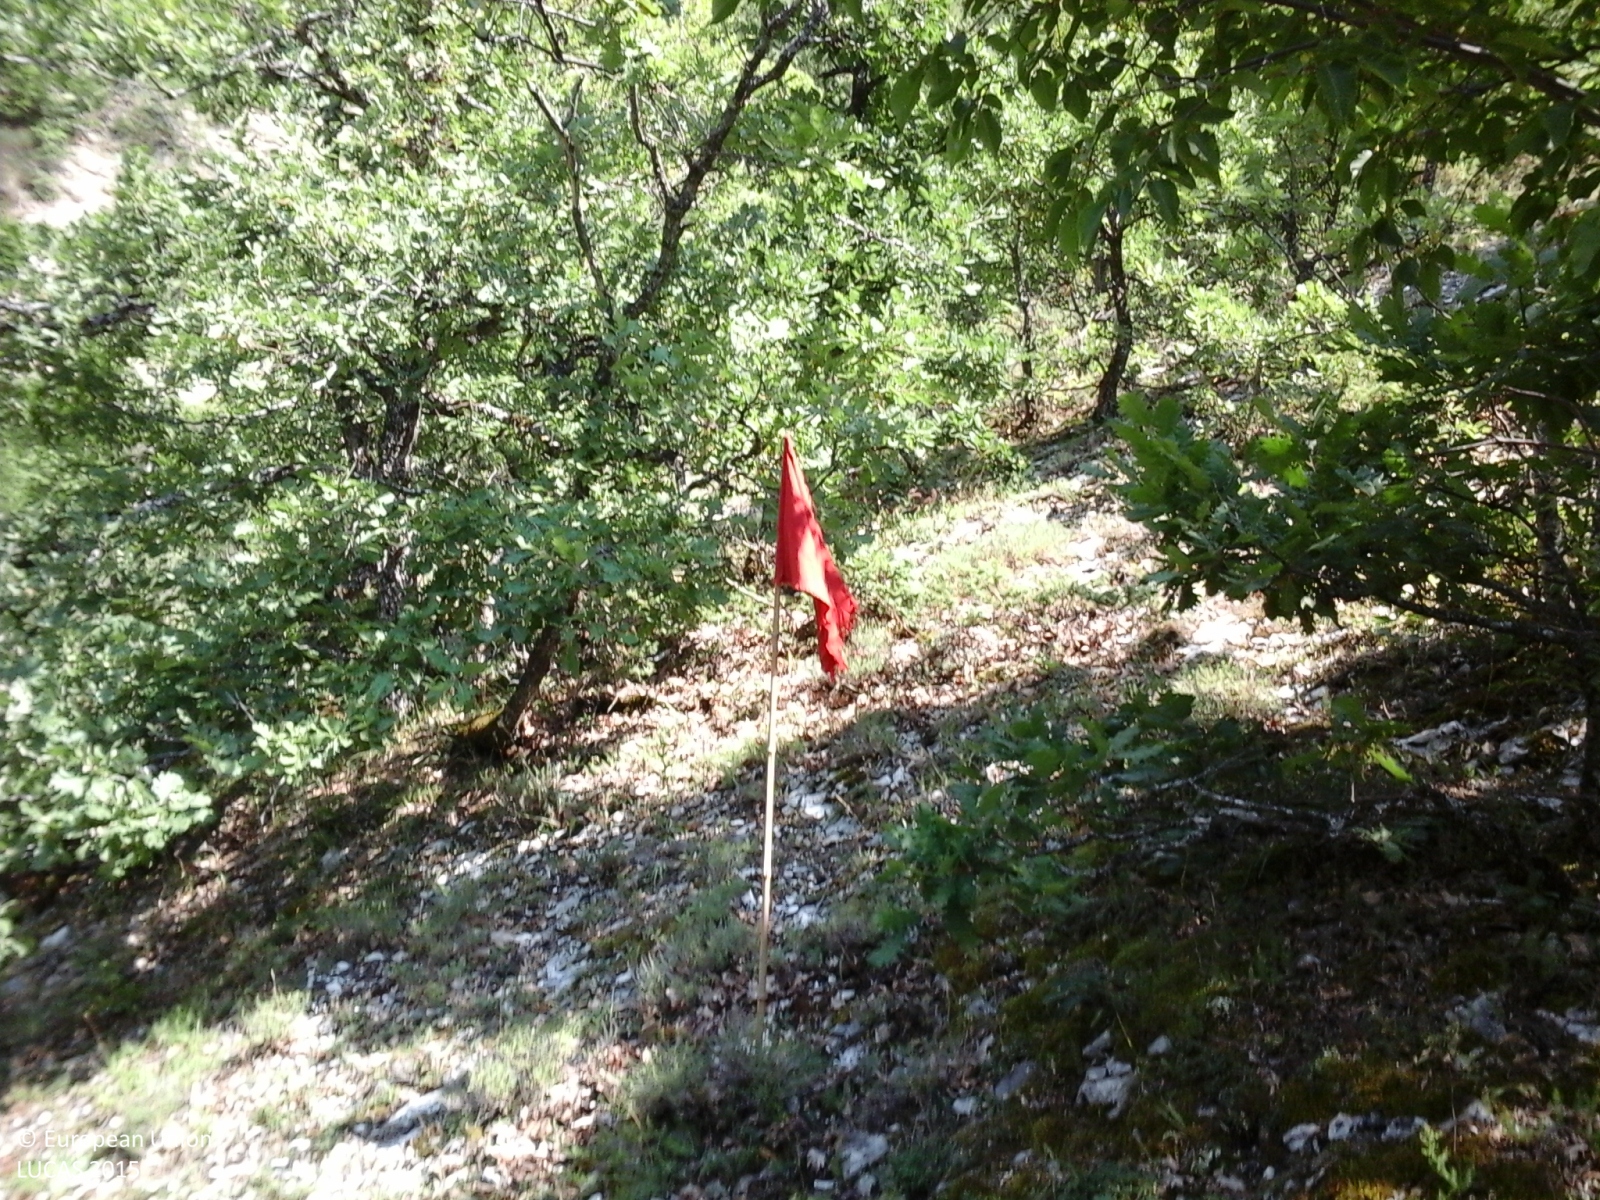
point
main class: Woodland
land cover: Broadleaved woodland
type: thermophilous deciduous forest
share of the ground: > 75 %
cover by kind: broadleaved forest trees 100 %
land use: Forestry
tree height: < 5 m
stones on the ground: > 50 %
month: August
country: IT
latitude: 42.9667
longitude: 13.1419
